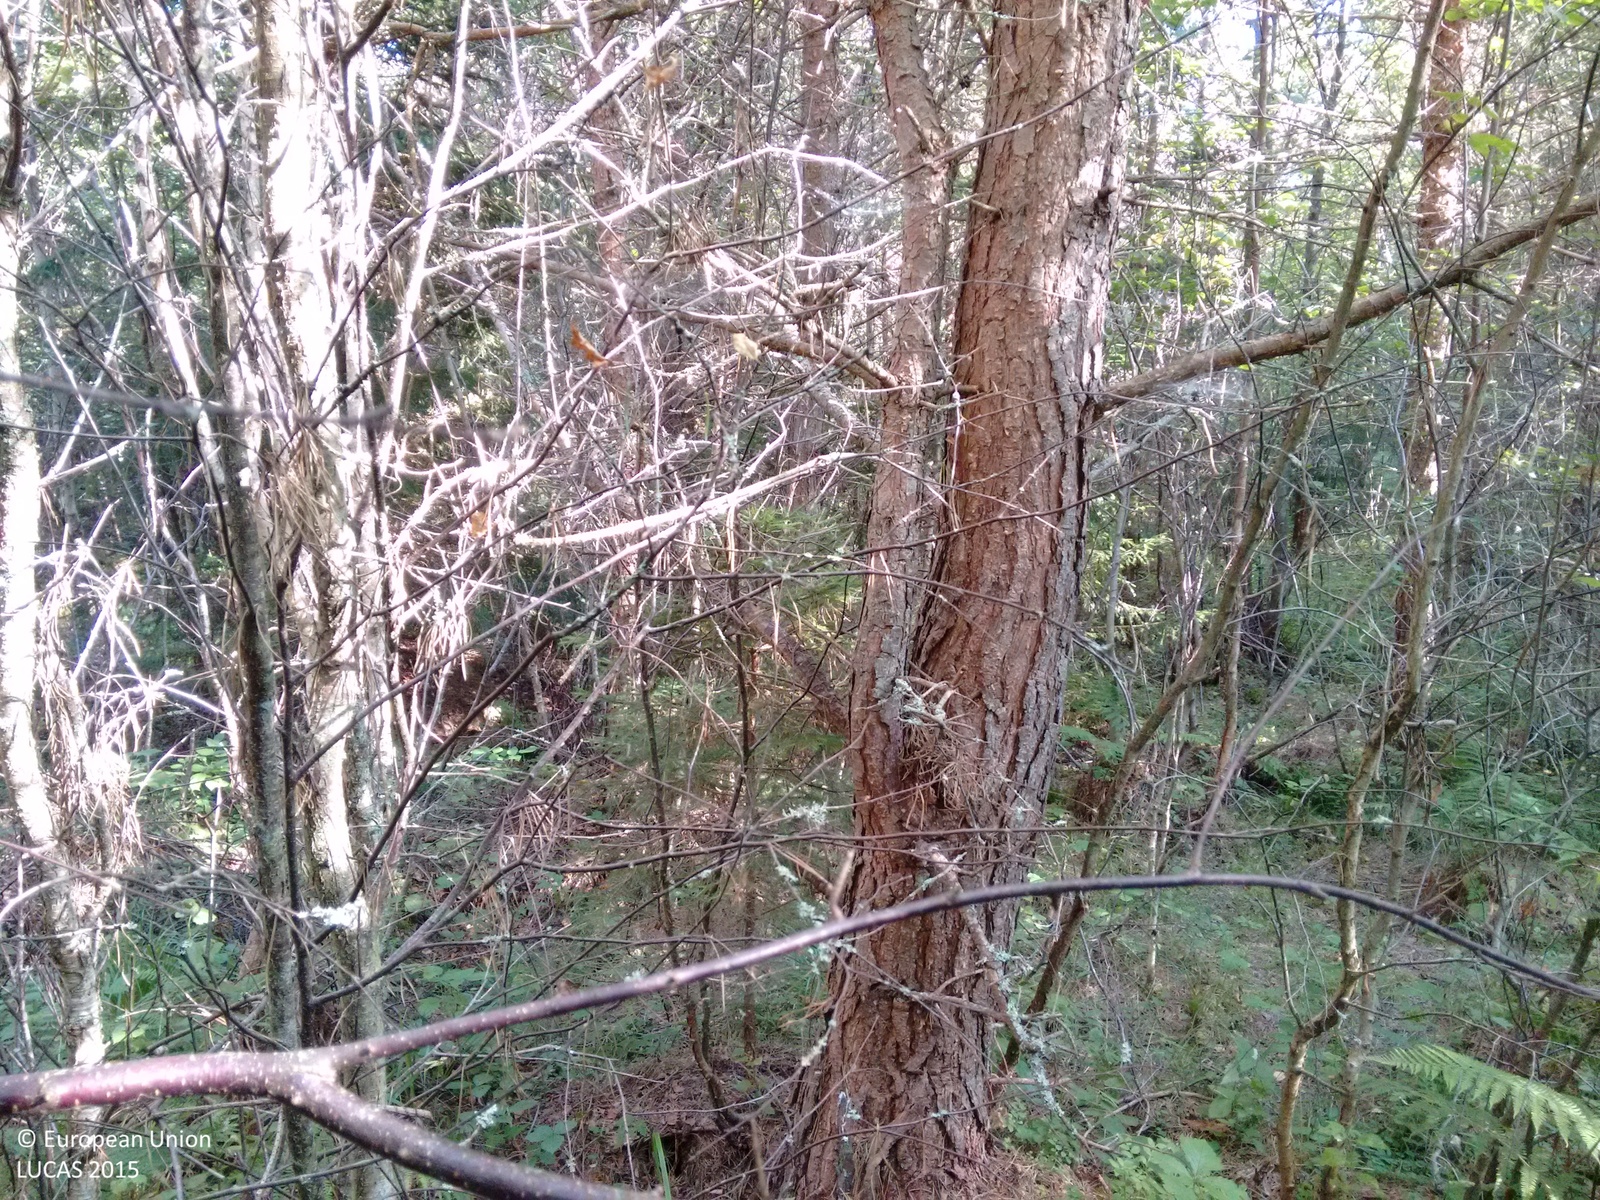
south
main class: Woodland
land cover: Pine dominated mixed woodland
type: hemiboreal forest and nemoral coniferous forest and mixed broadleaved-coniferous forest
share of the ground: > 75 %
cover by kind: coniferous forest trees 55 %, broadleaved forest trees 30 %, herbaceous plants 15 %
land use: Forestry
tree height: > 5 m
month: August
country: FI
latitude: 60.1632
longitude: 19.5717
